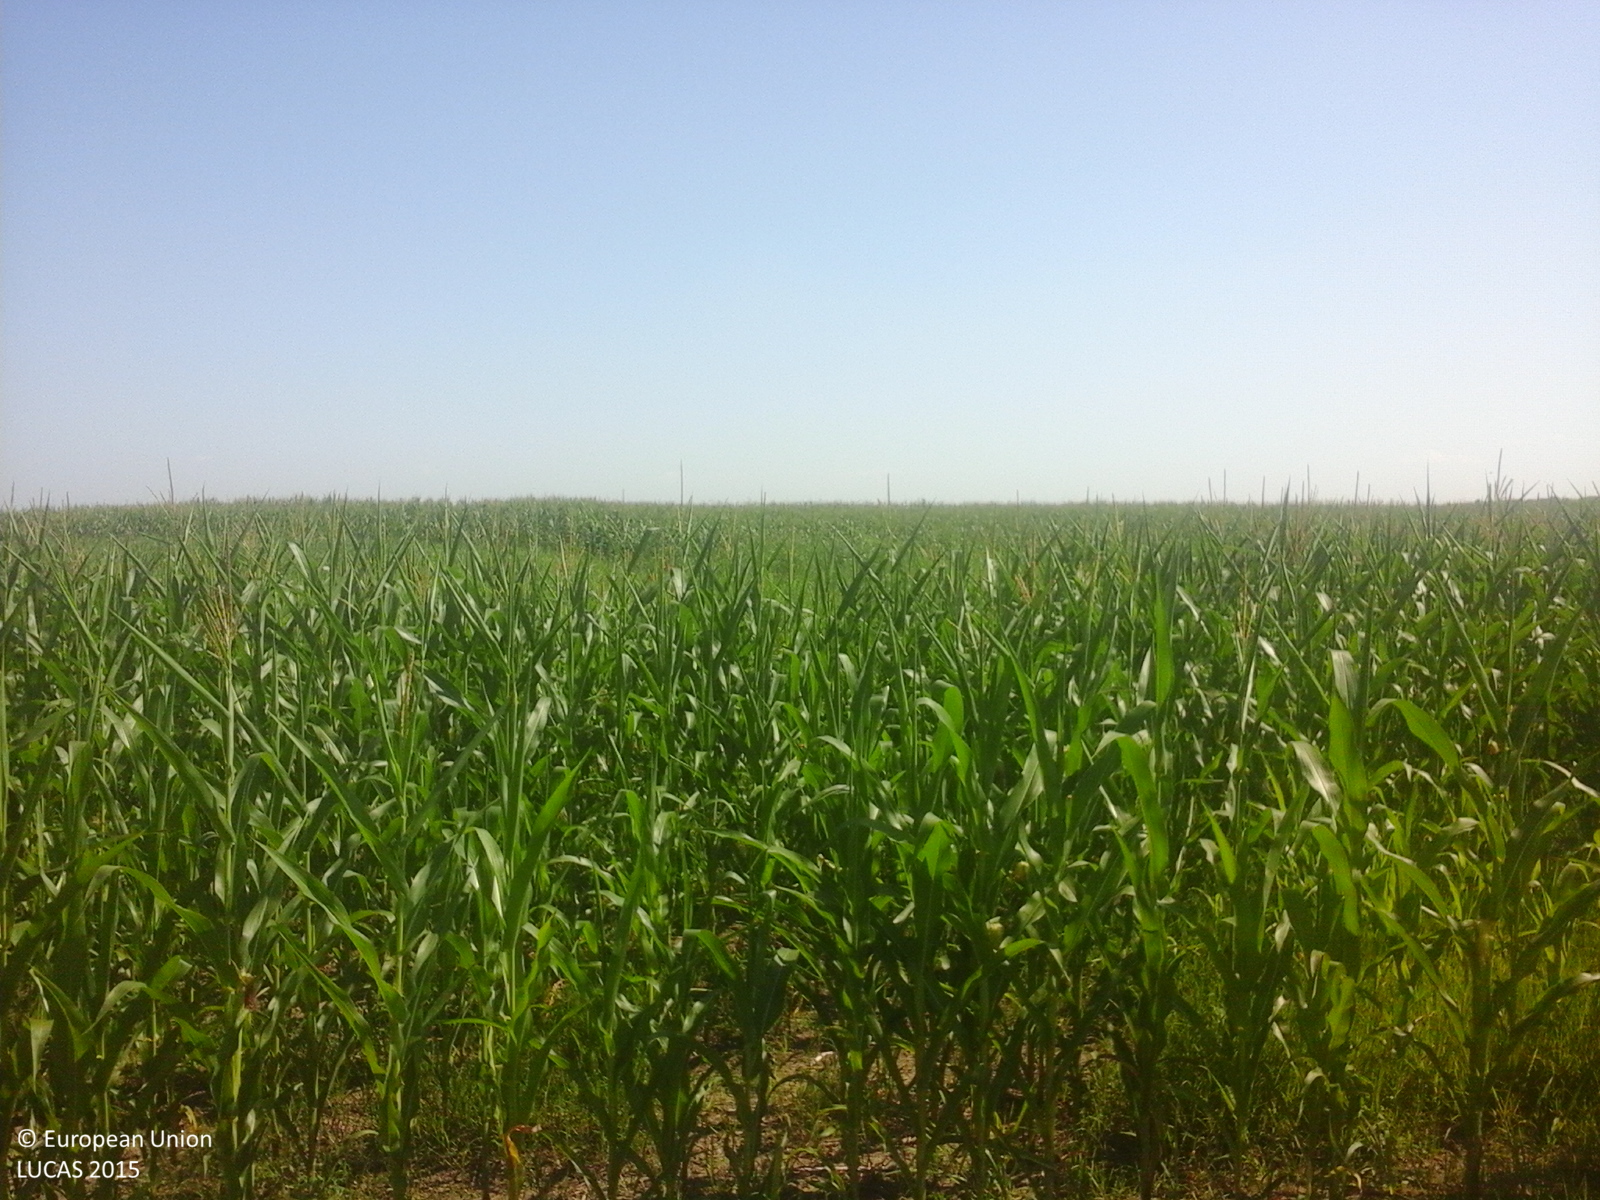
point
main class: Cropland
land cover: Maize
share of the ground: > 75 %
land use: Agriculture (excluding fallow land and kitchen gardens)
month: July
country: RO
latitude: 44.4158
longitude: 24.2957
